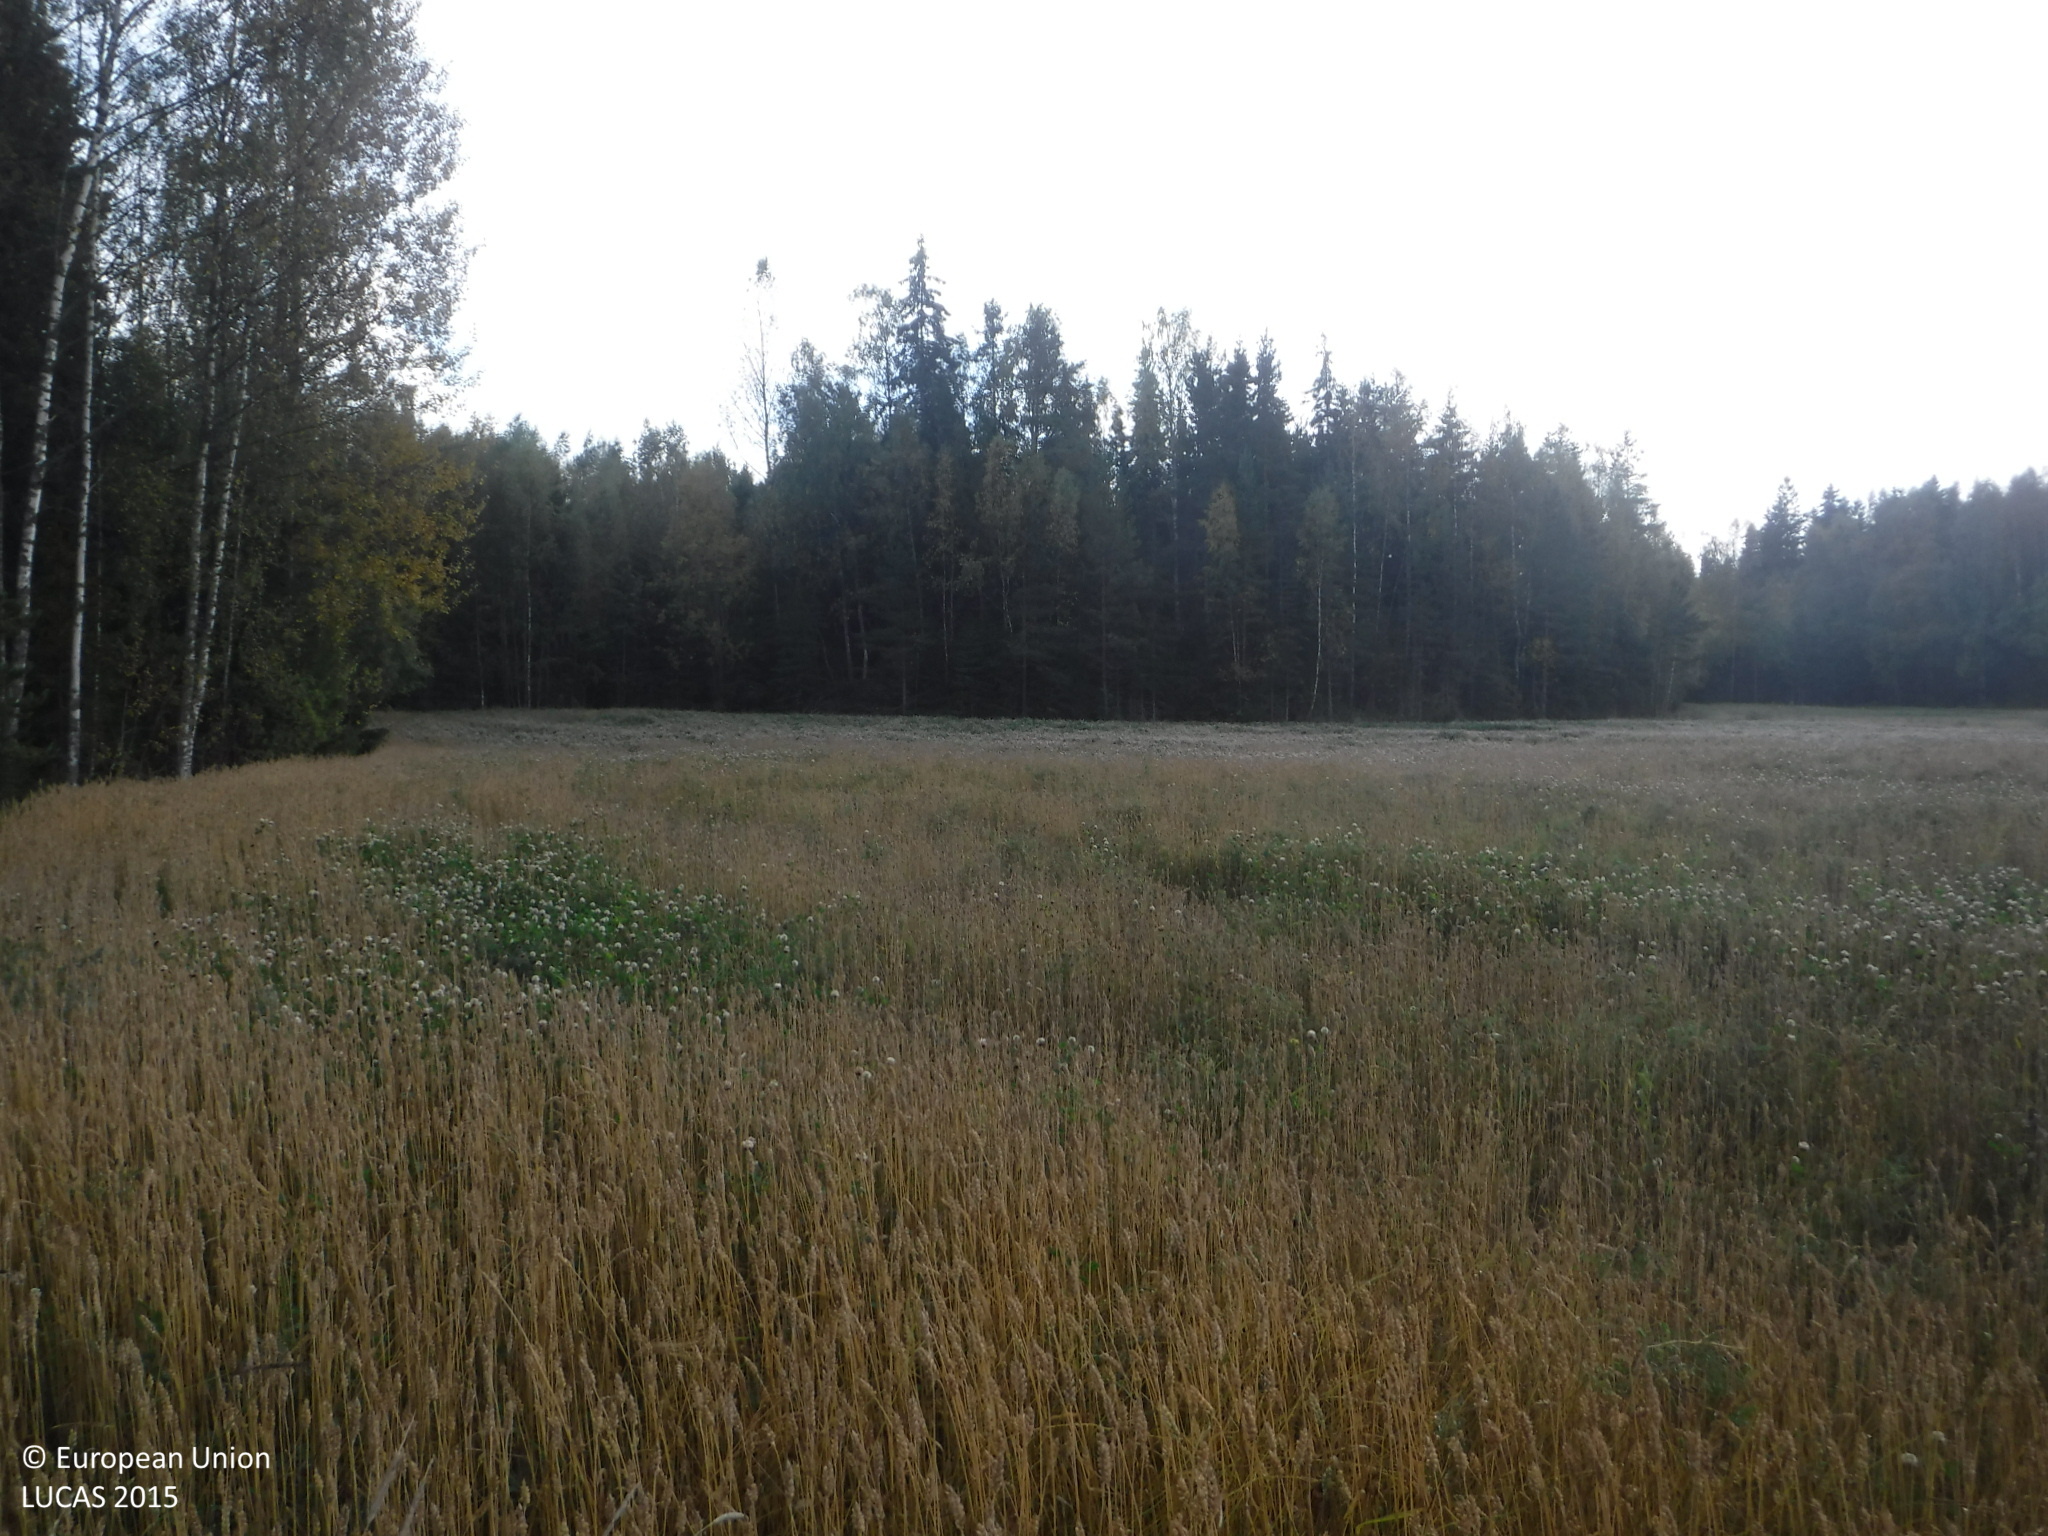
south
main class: Cropland
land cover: Other leguminous and mixtures for fodder
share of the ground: > 75 %
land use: Agriculture (excluding fallow land and kitchen gardens)
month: September
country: FI
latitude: 61.6880
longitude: 21.5987
